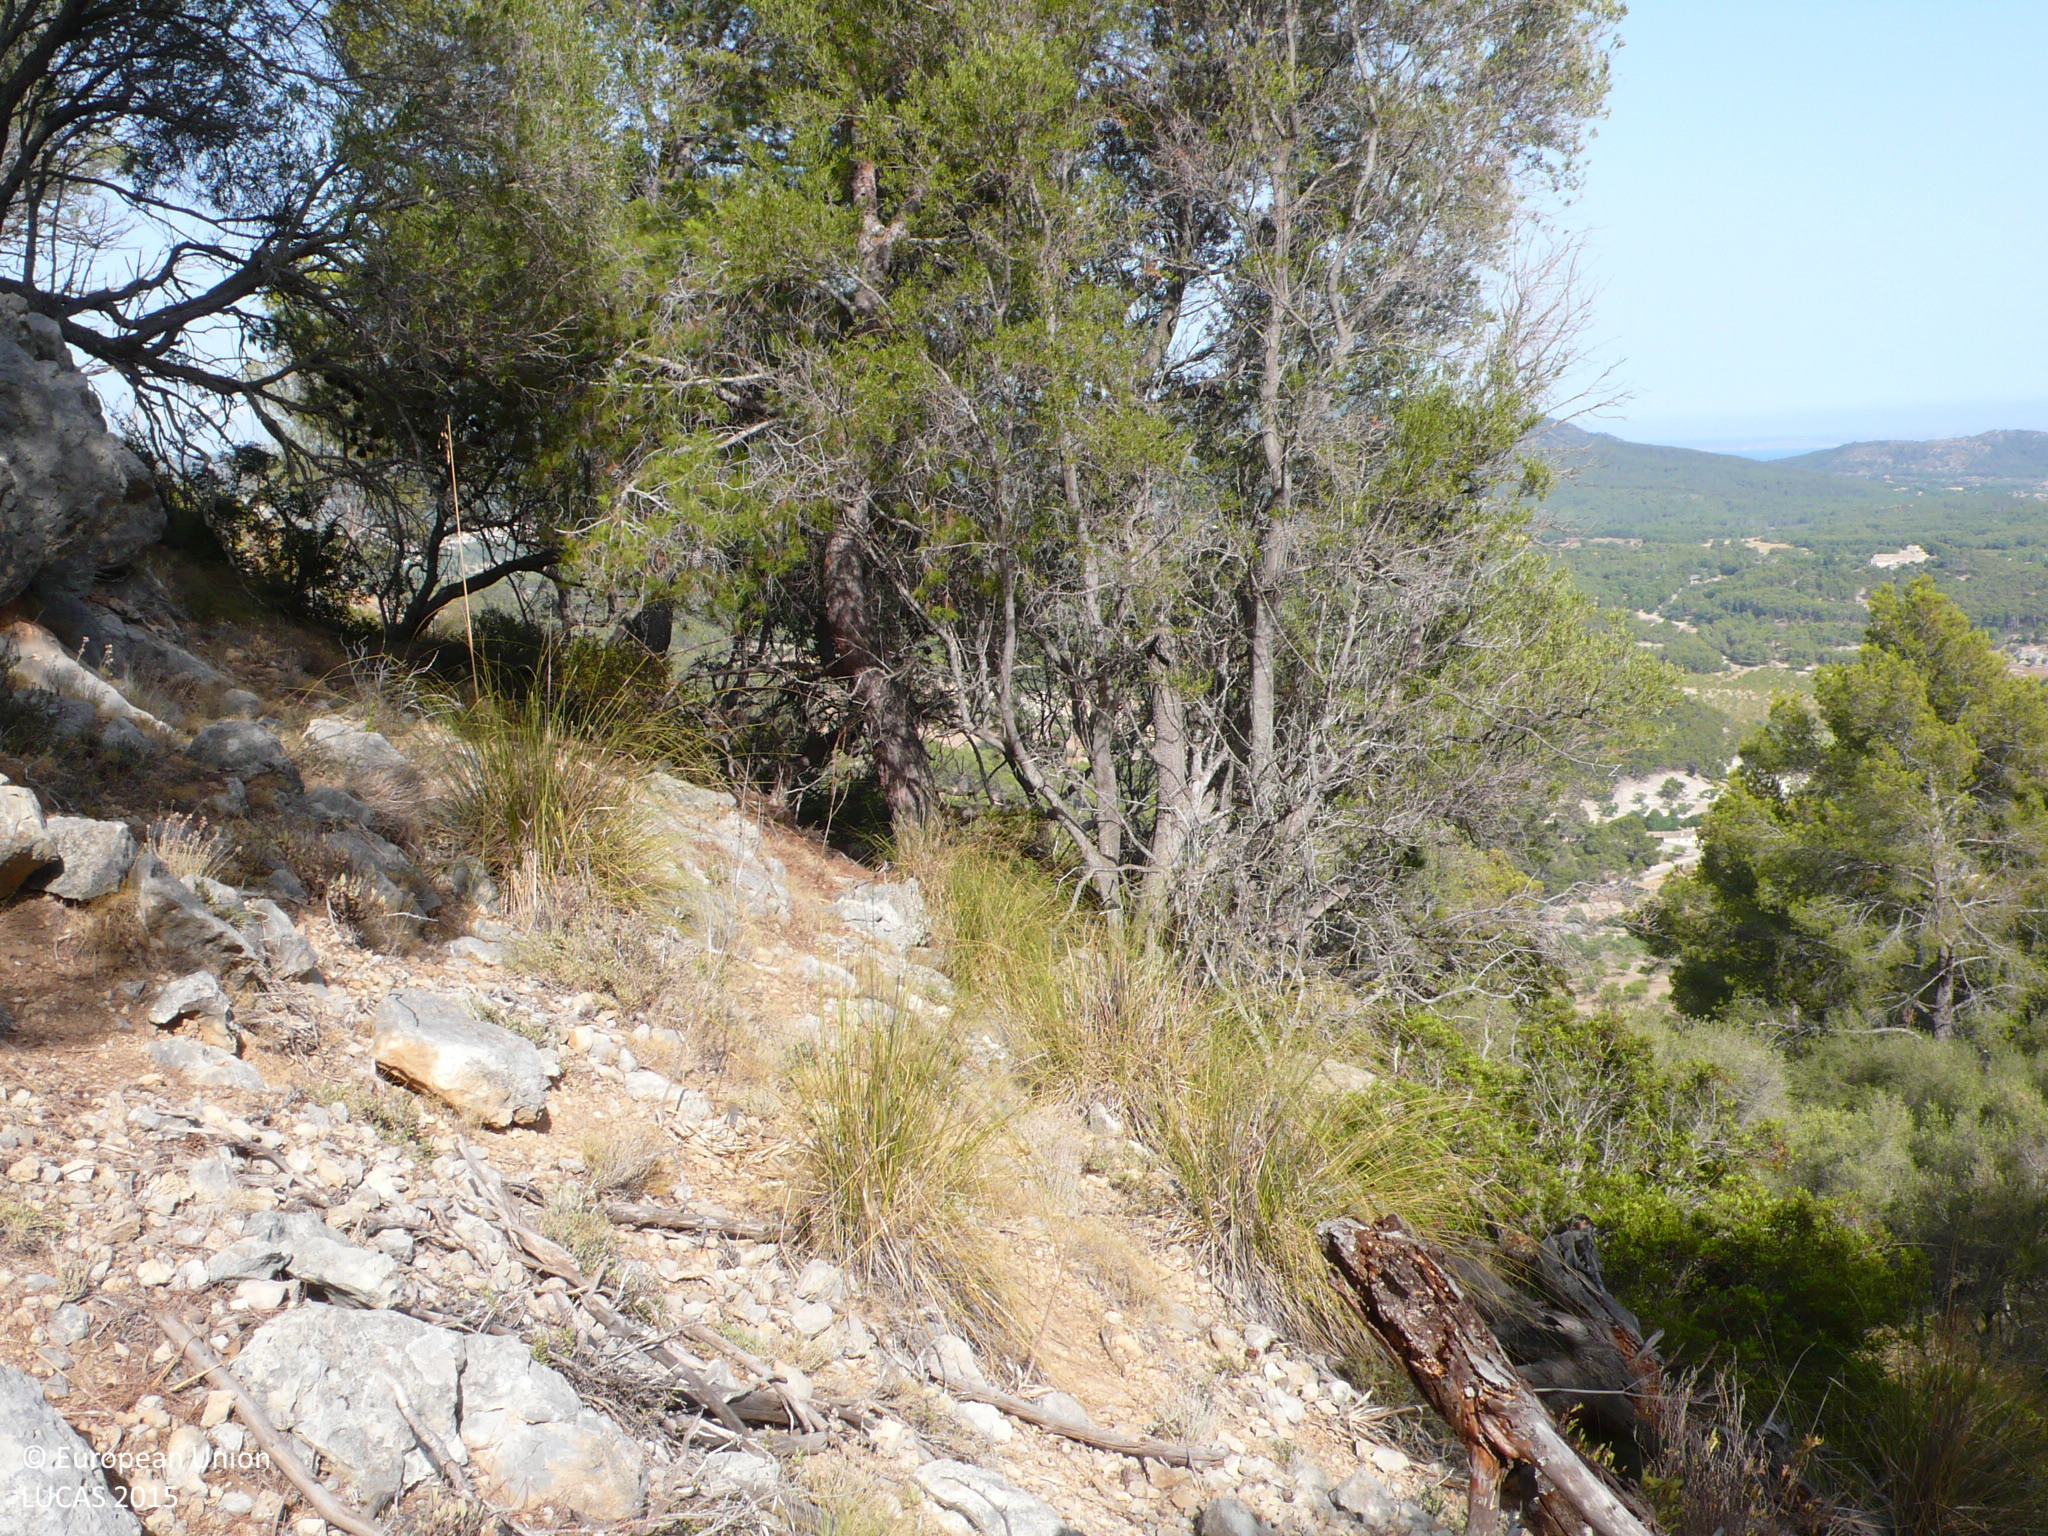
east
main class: Woodland
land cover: Pine dominated mixed woodland
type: coniferous forest of the mediterranean region
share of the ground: 50 - 75 %
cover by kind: coniferous forest trees 40 %, consolidated bare surface 25 %, shrubs 20 %, broadleaved forest trees 15 %
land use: Semi-natural and natural areas not in use
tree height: > 5 m
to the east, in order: Pine dominated mixed woodland; Shrubland with sparse tree cover; Pine dominated mixed woodland
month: August
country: ES
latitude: 39.5584
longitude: 2.4540
